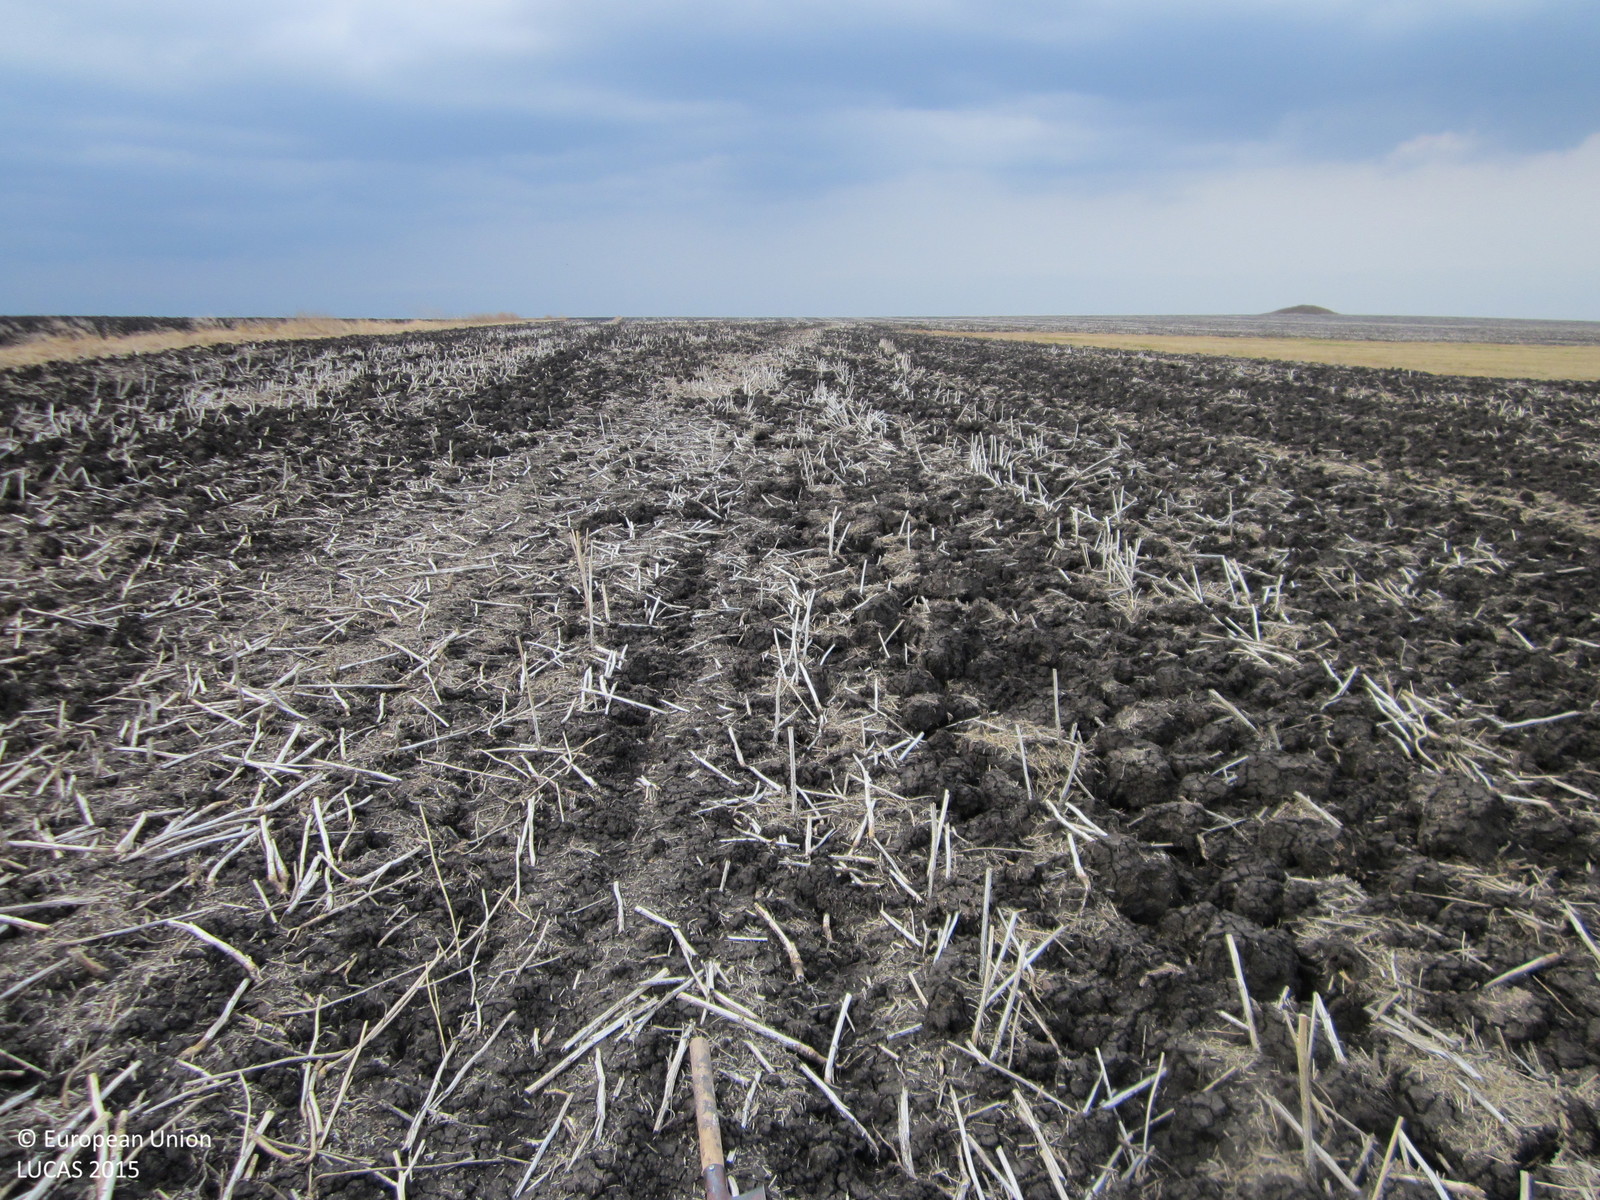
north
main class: Cropland
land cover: Sunflower
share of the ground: 10 - 25 %
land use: Agriculture (excluding fallow land and kitchen gardens)
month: August
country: BG
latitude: 42.4575
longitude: 26.9946
